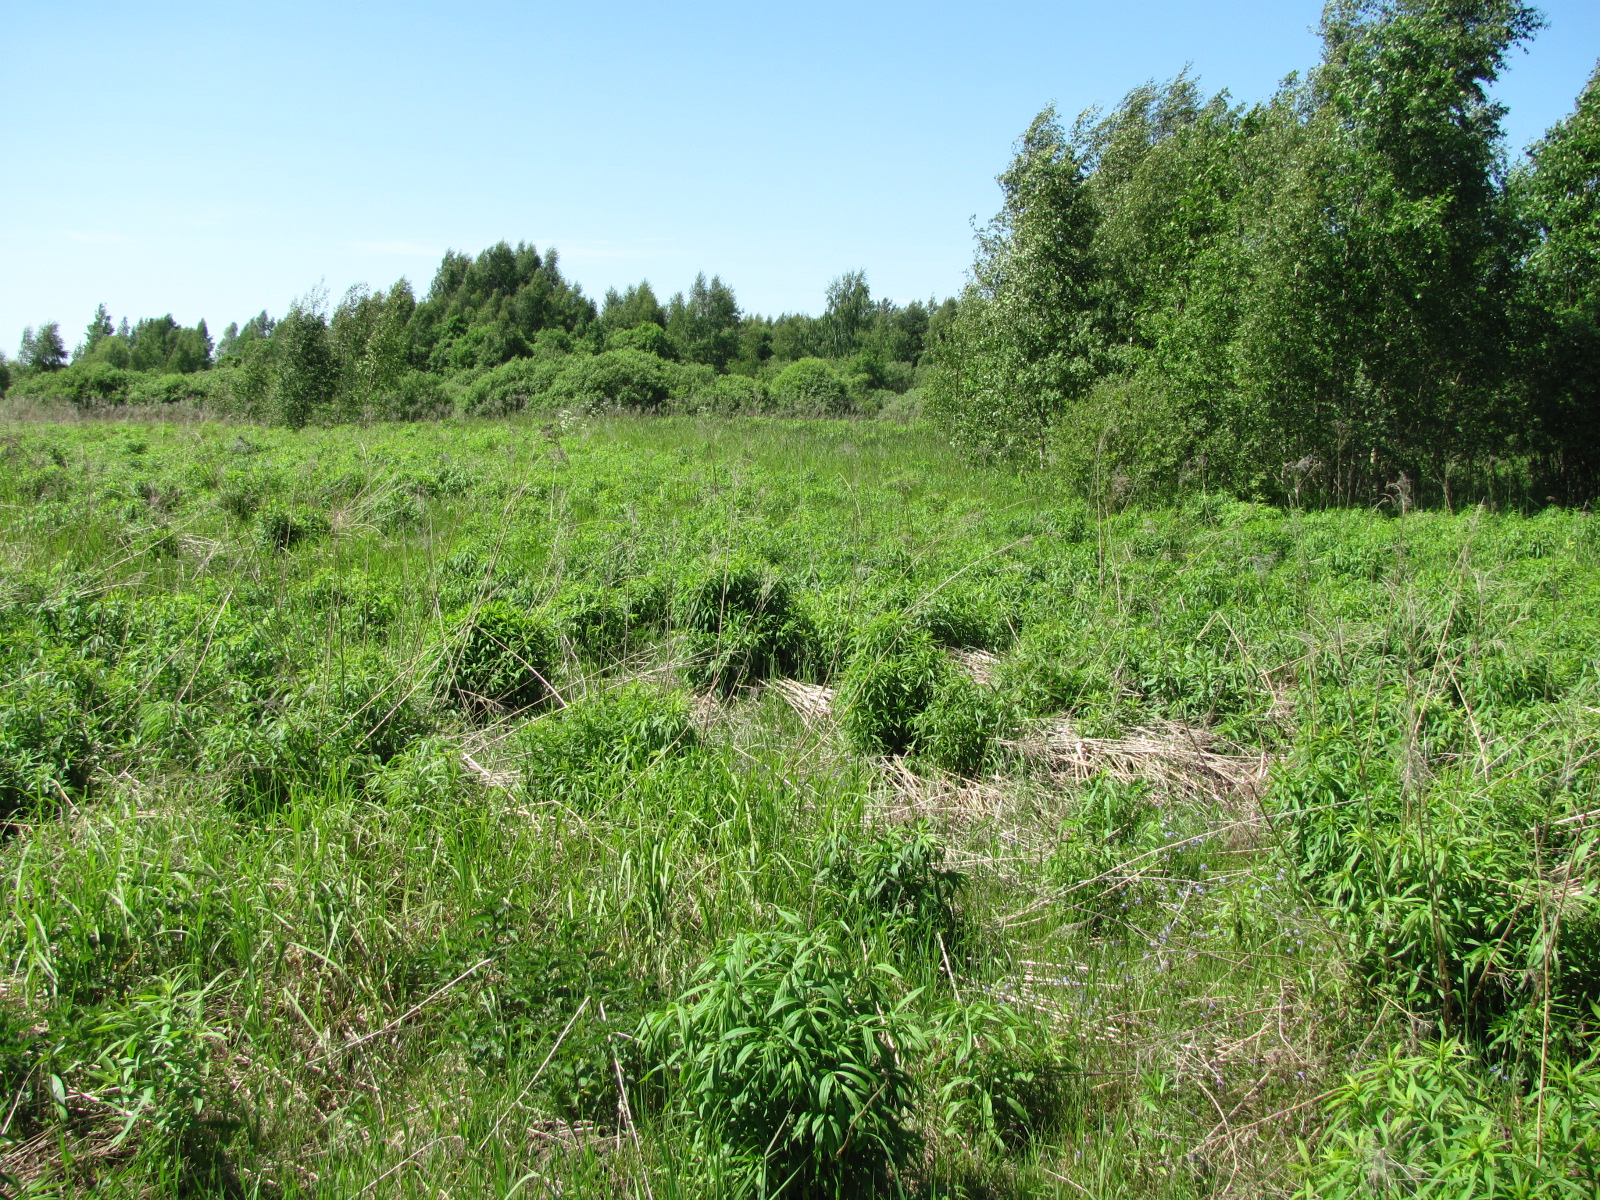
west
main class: Grassland
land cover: Spontaneously vegetated surfaces
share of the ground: > 75 %
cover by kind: herbaceous plants 100 %
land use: Fallow land
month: June
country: LV
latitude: 56.5281
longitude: 24.3502
